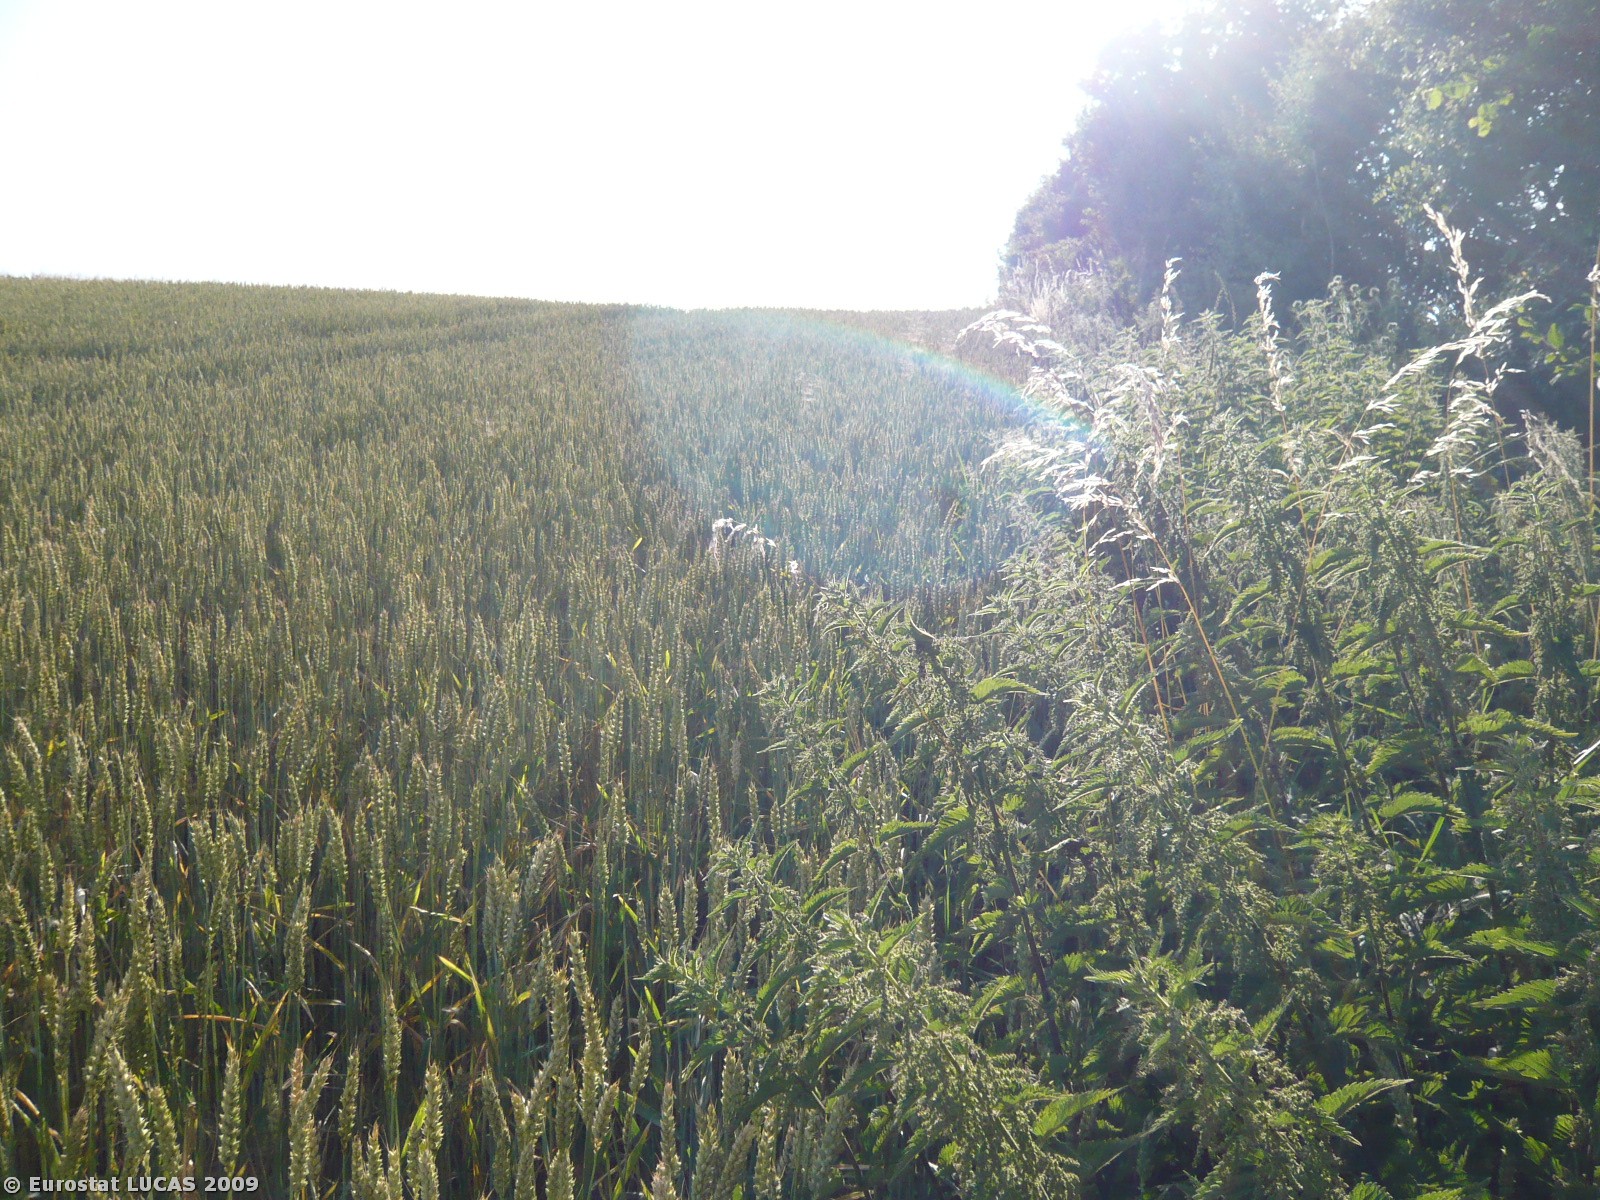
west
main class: Cropland
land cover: Common wheat
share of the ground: > 75 %
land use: Agriculture (excluding fallow land and kitchen gardens)
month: July
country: DK
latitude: 55.6043
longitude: 11.4431
